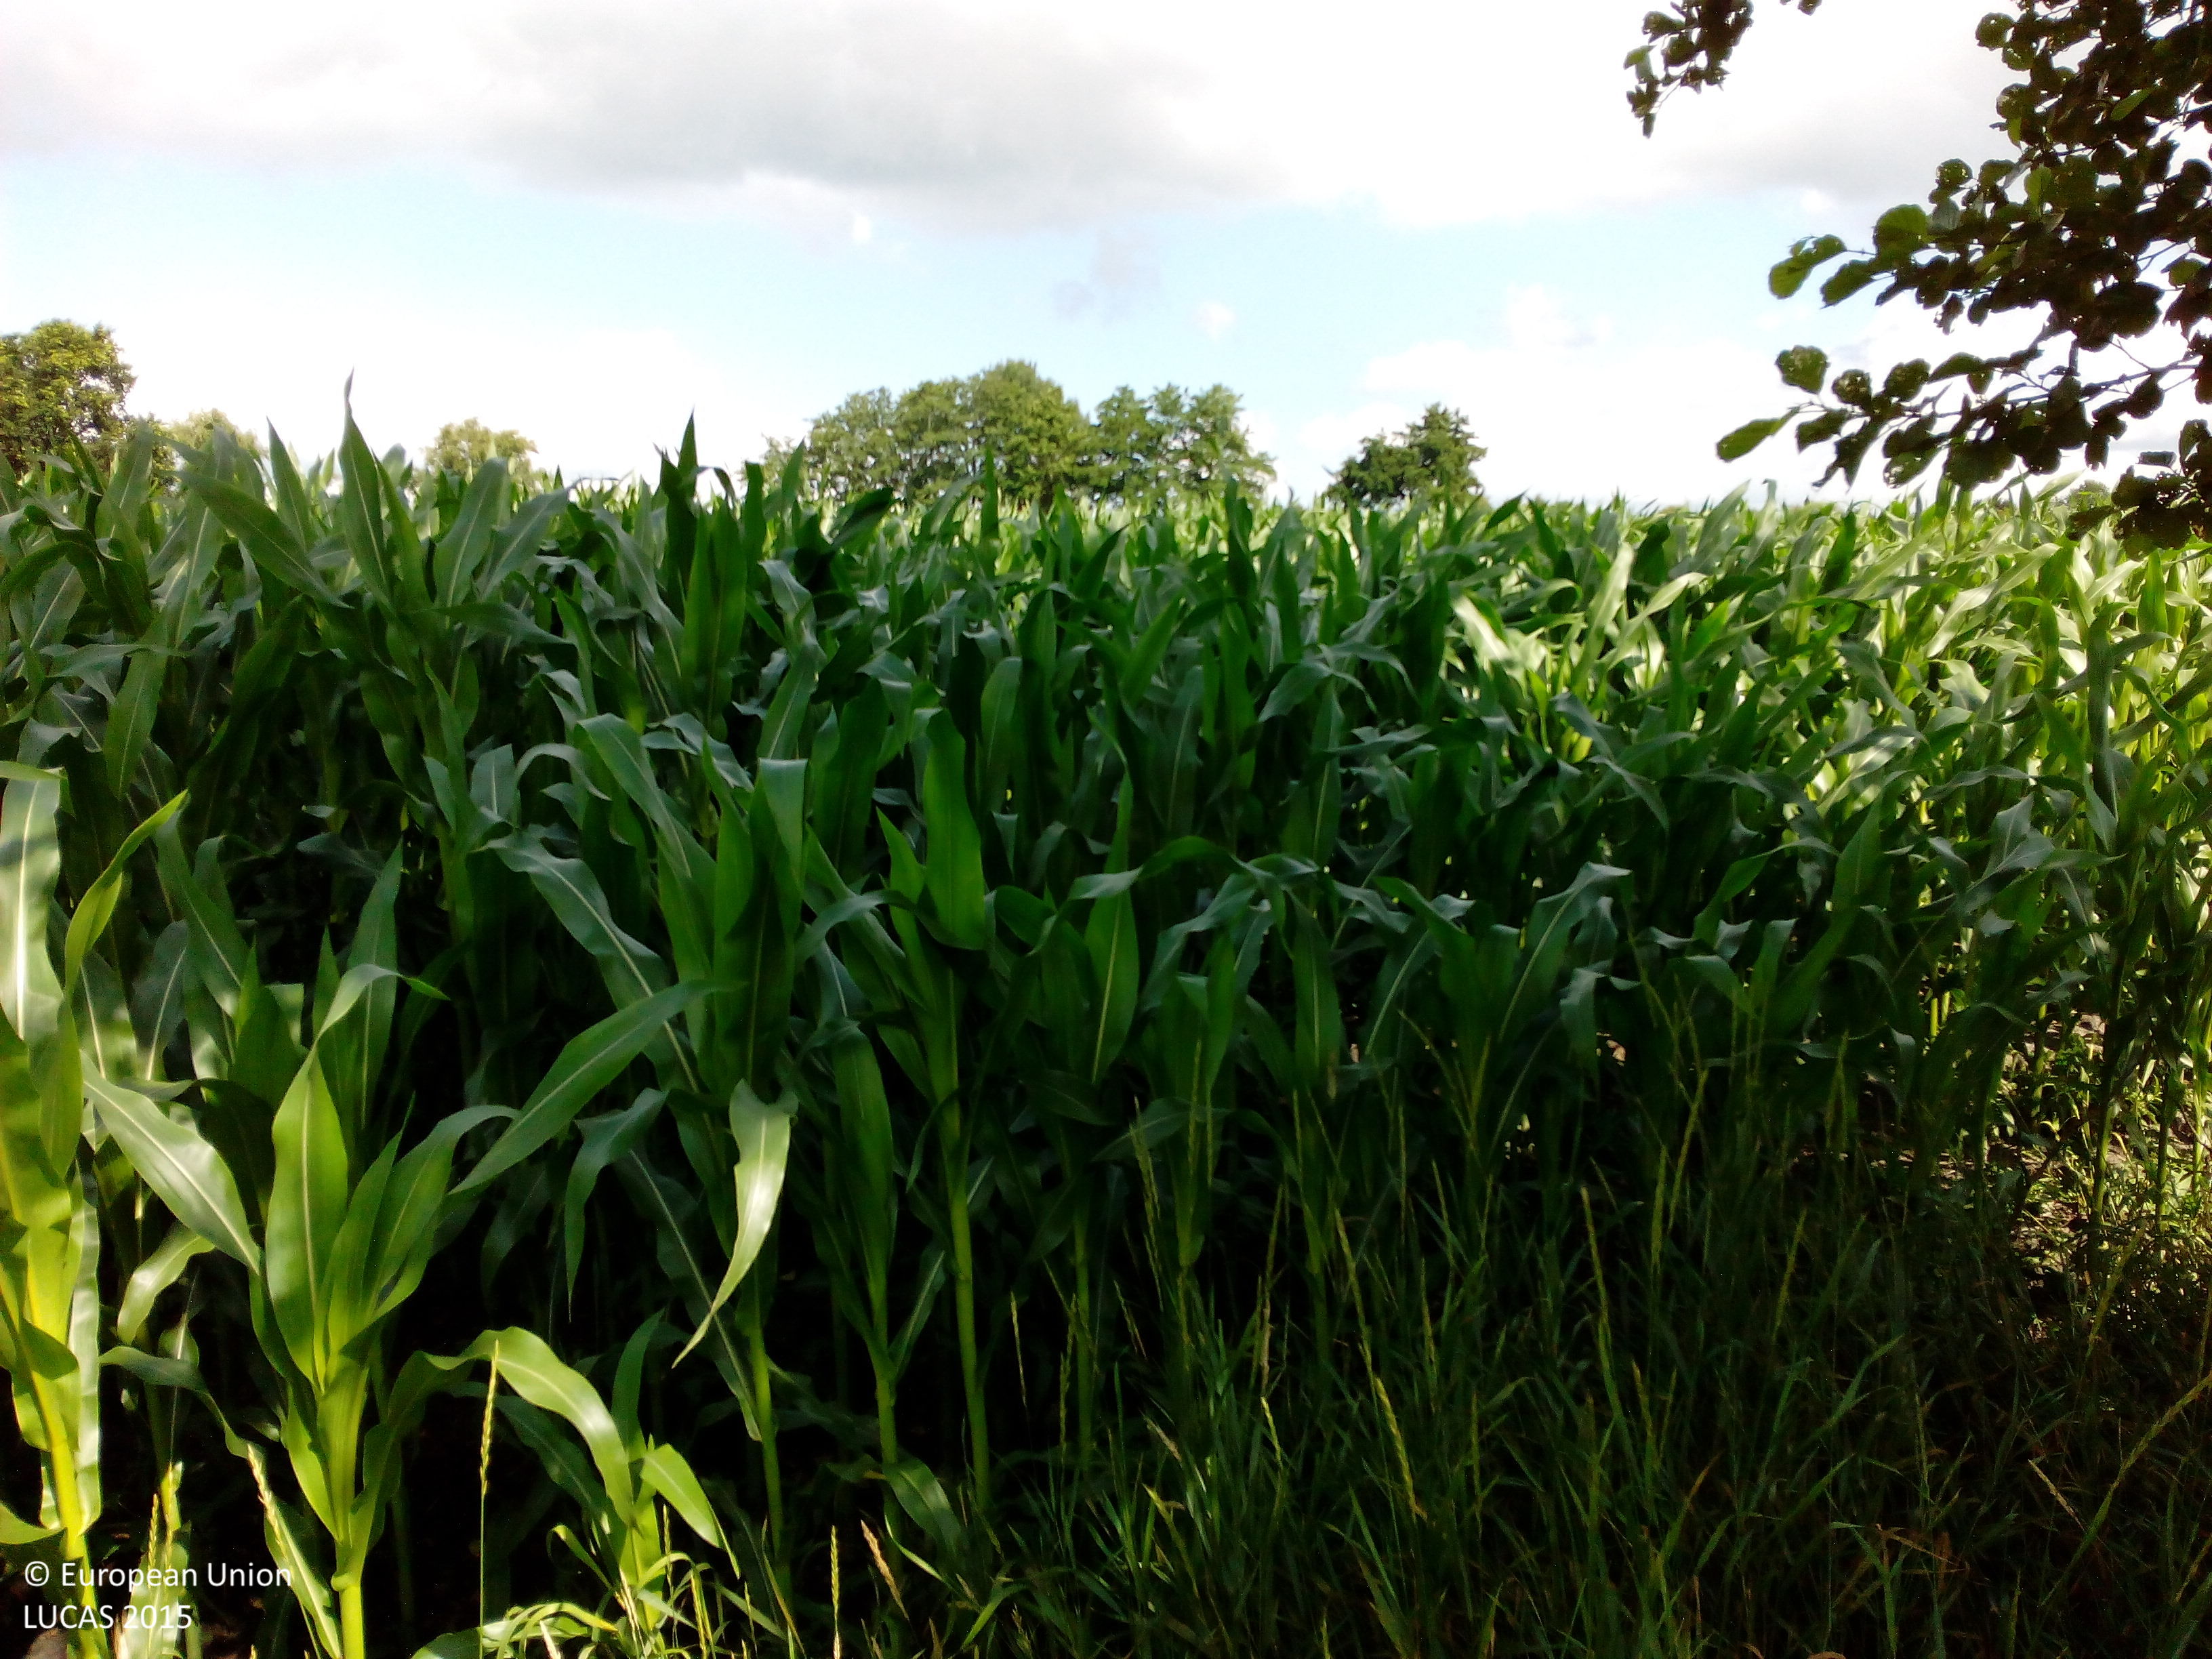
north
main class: Cropland
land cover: Maize
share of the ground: > 75 %
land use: Agriculture (excluding fallow land and kitchen gardens)
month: July
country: DE
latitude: 53.1324
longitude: 7.9231
